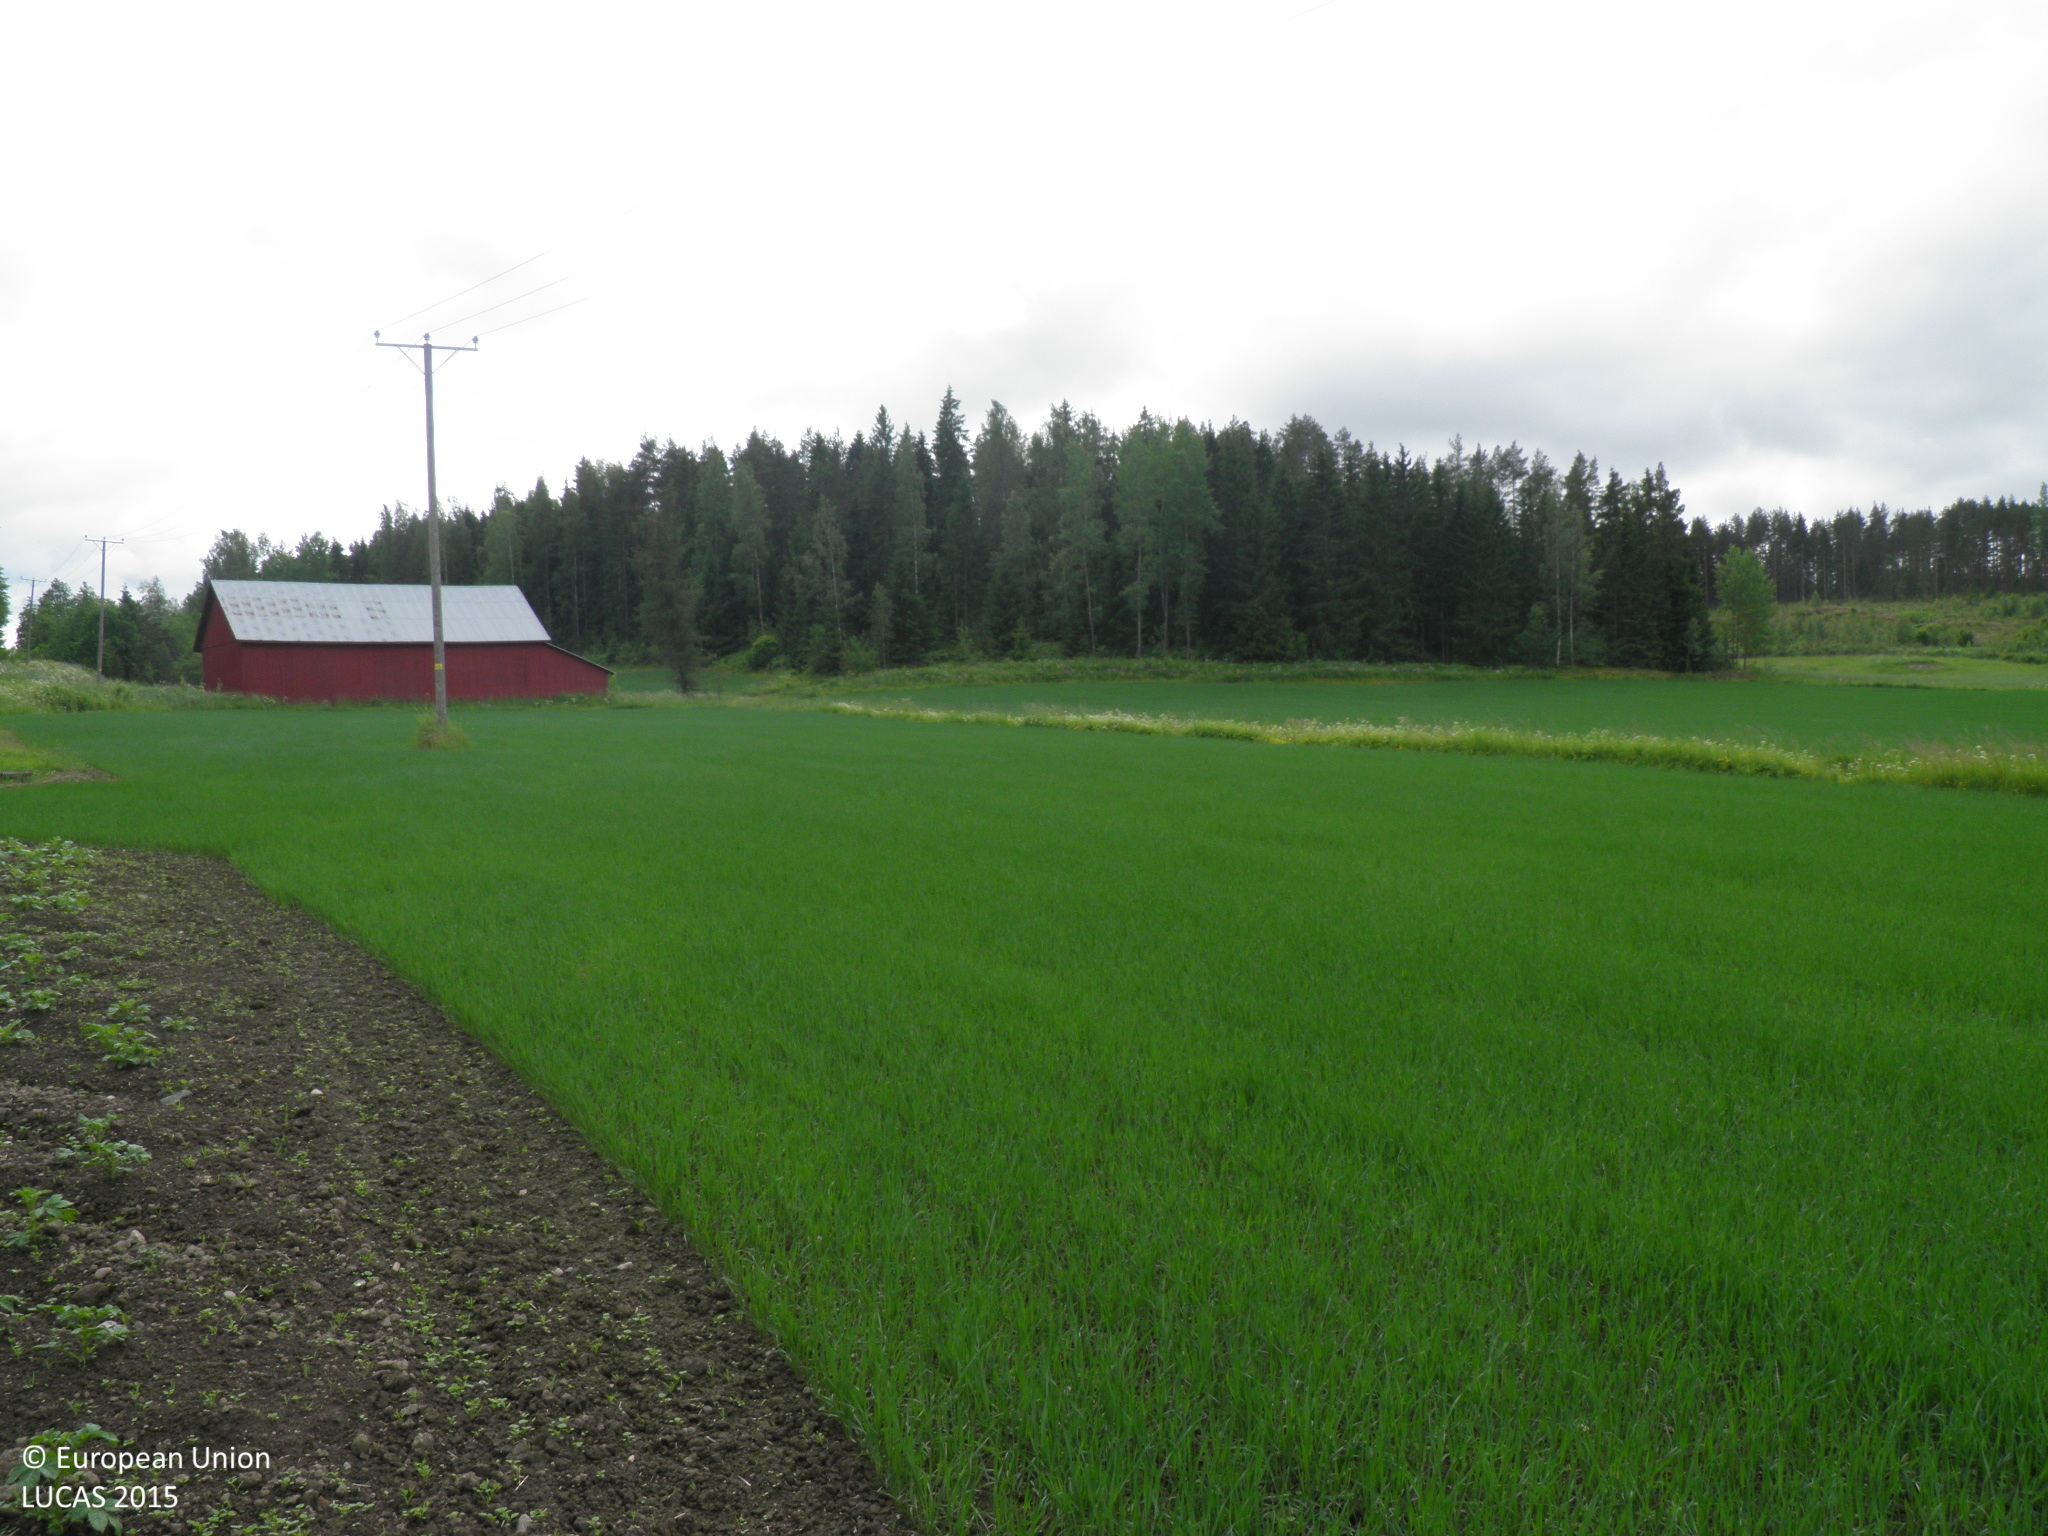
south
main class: Cropland
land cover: Common wheat
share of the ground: > 75 %
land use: Agriculture (excluding fallow land and kitchen gardens)
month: June
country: FI
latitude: 60.3968
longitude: 23.0185
